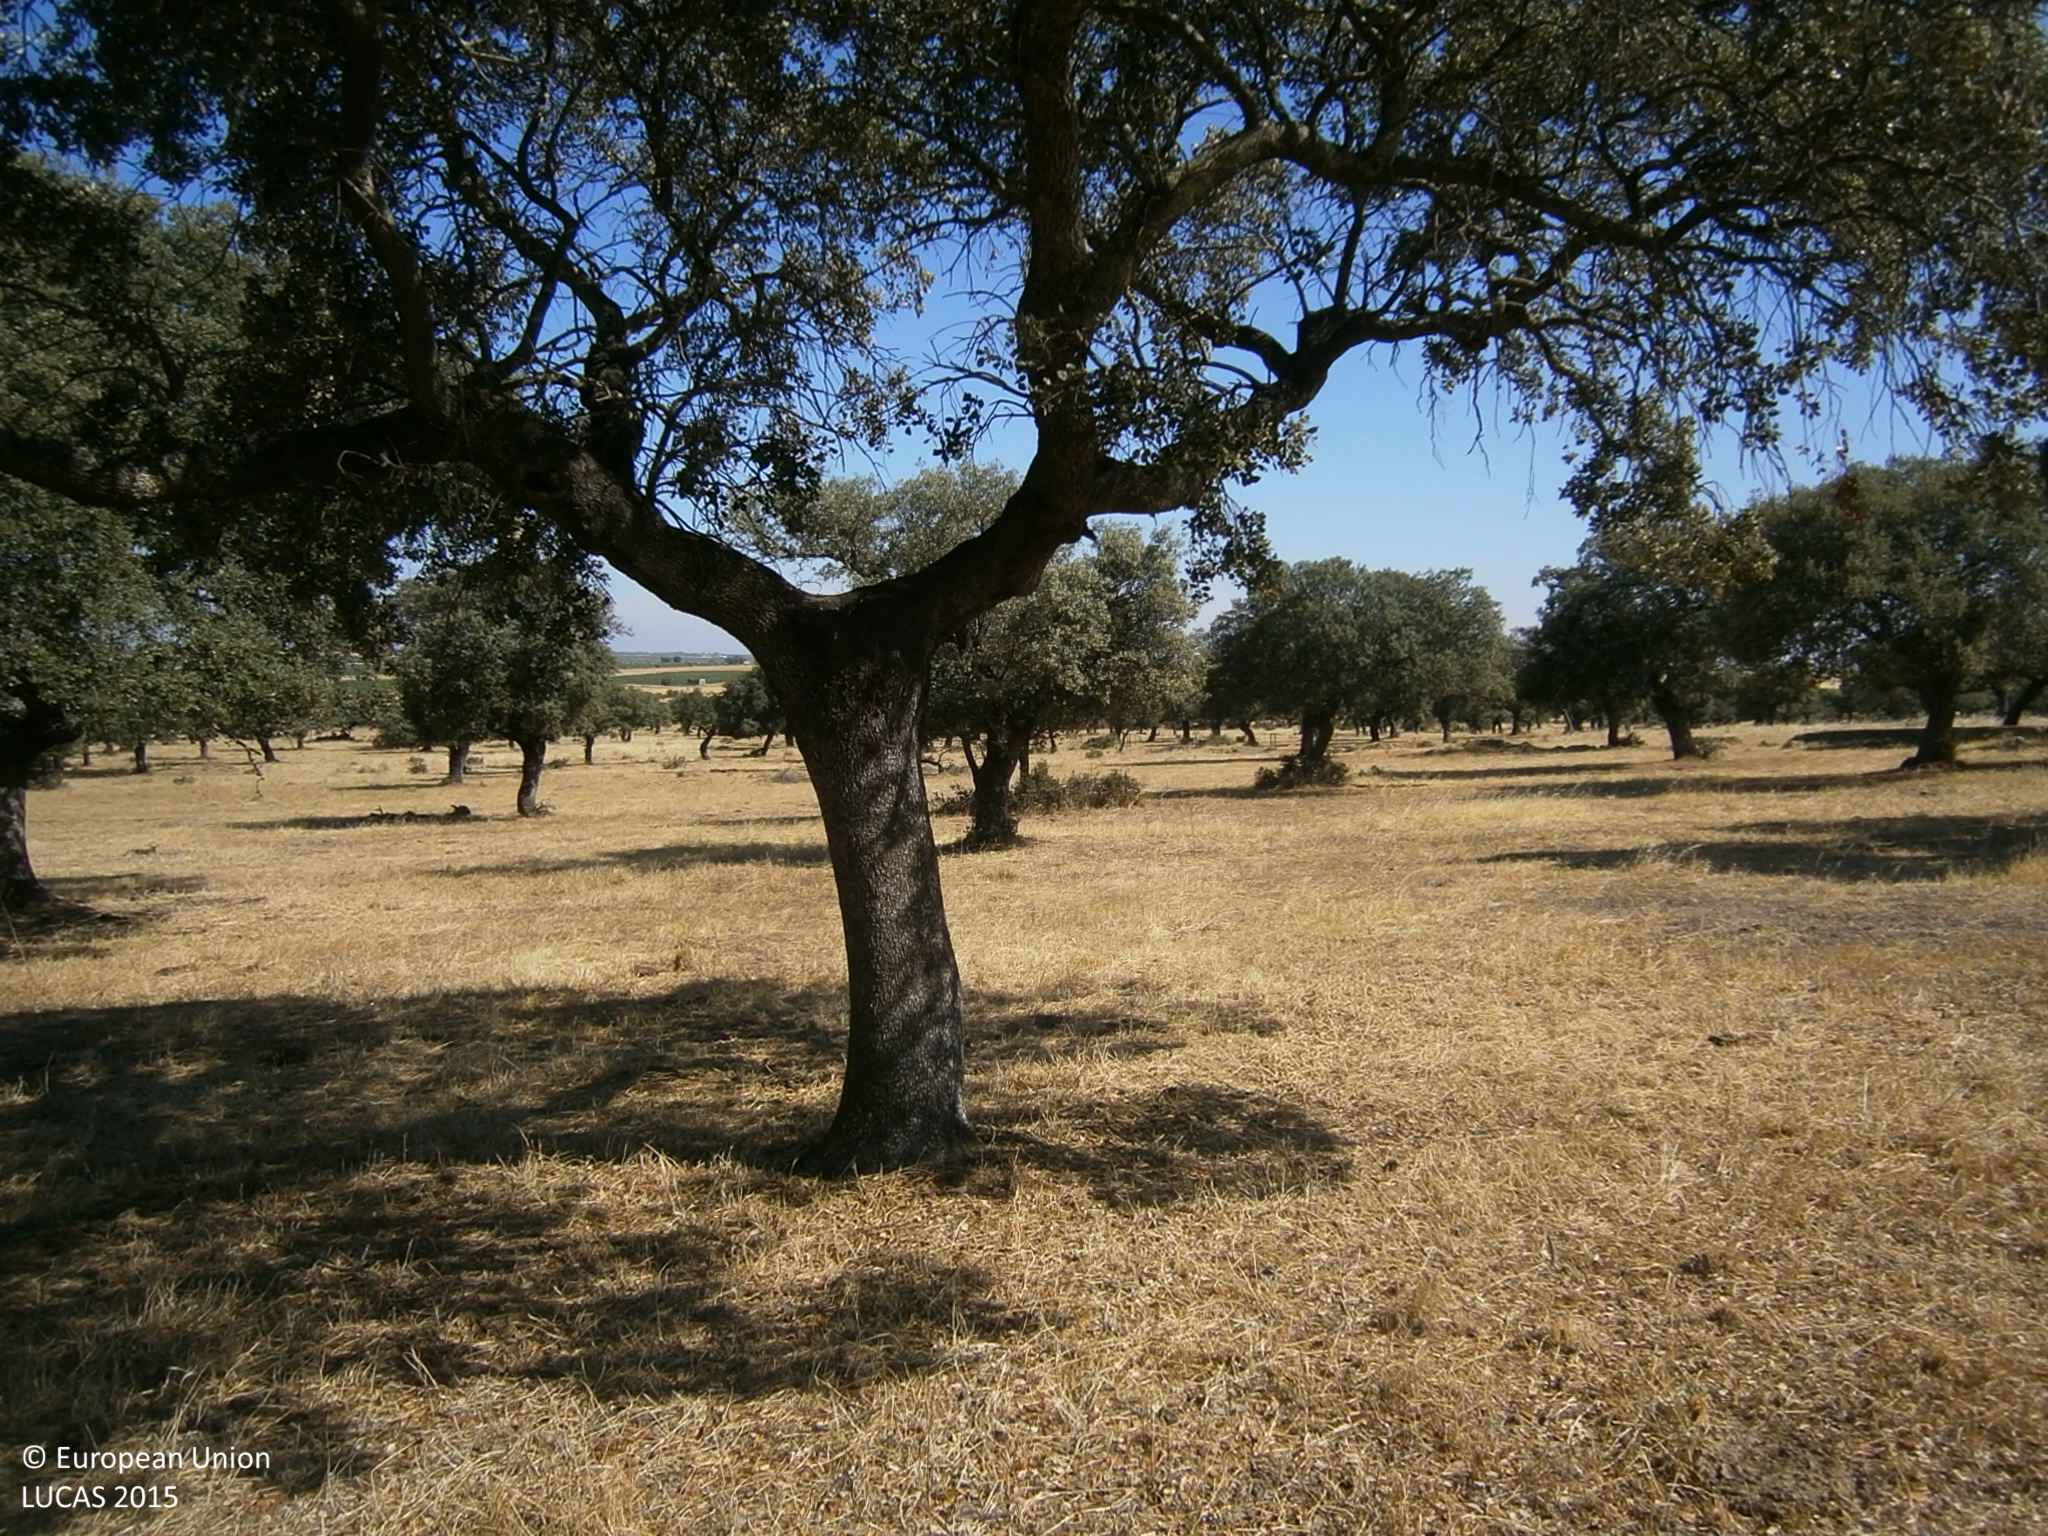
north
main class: Woodland
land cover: Broadleaved woodland
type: broadleaved evergreen forest
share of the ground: 50 - 75 %
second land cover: Spontaneously vegetated surfaces
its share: 25 - 50 %
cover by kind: broadleaved forest trees 50 %, herbaceous plants 45 %, shrubs 5 %
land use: Forestry
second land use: Agriculture (excluding fallow land and kitchen gardens)
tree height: > 5 m
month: June
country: ES
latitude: 38.6874
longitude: -6.9540
